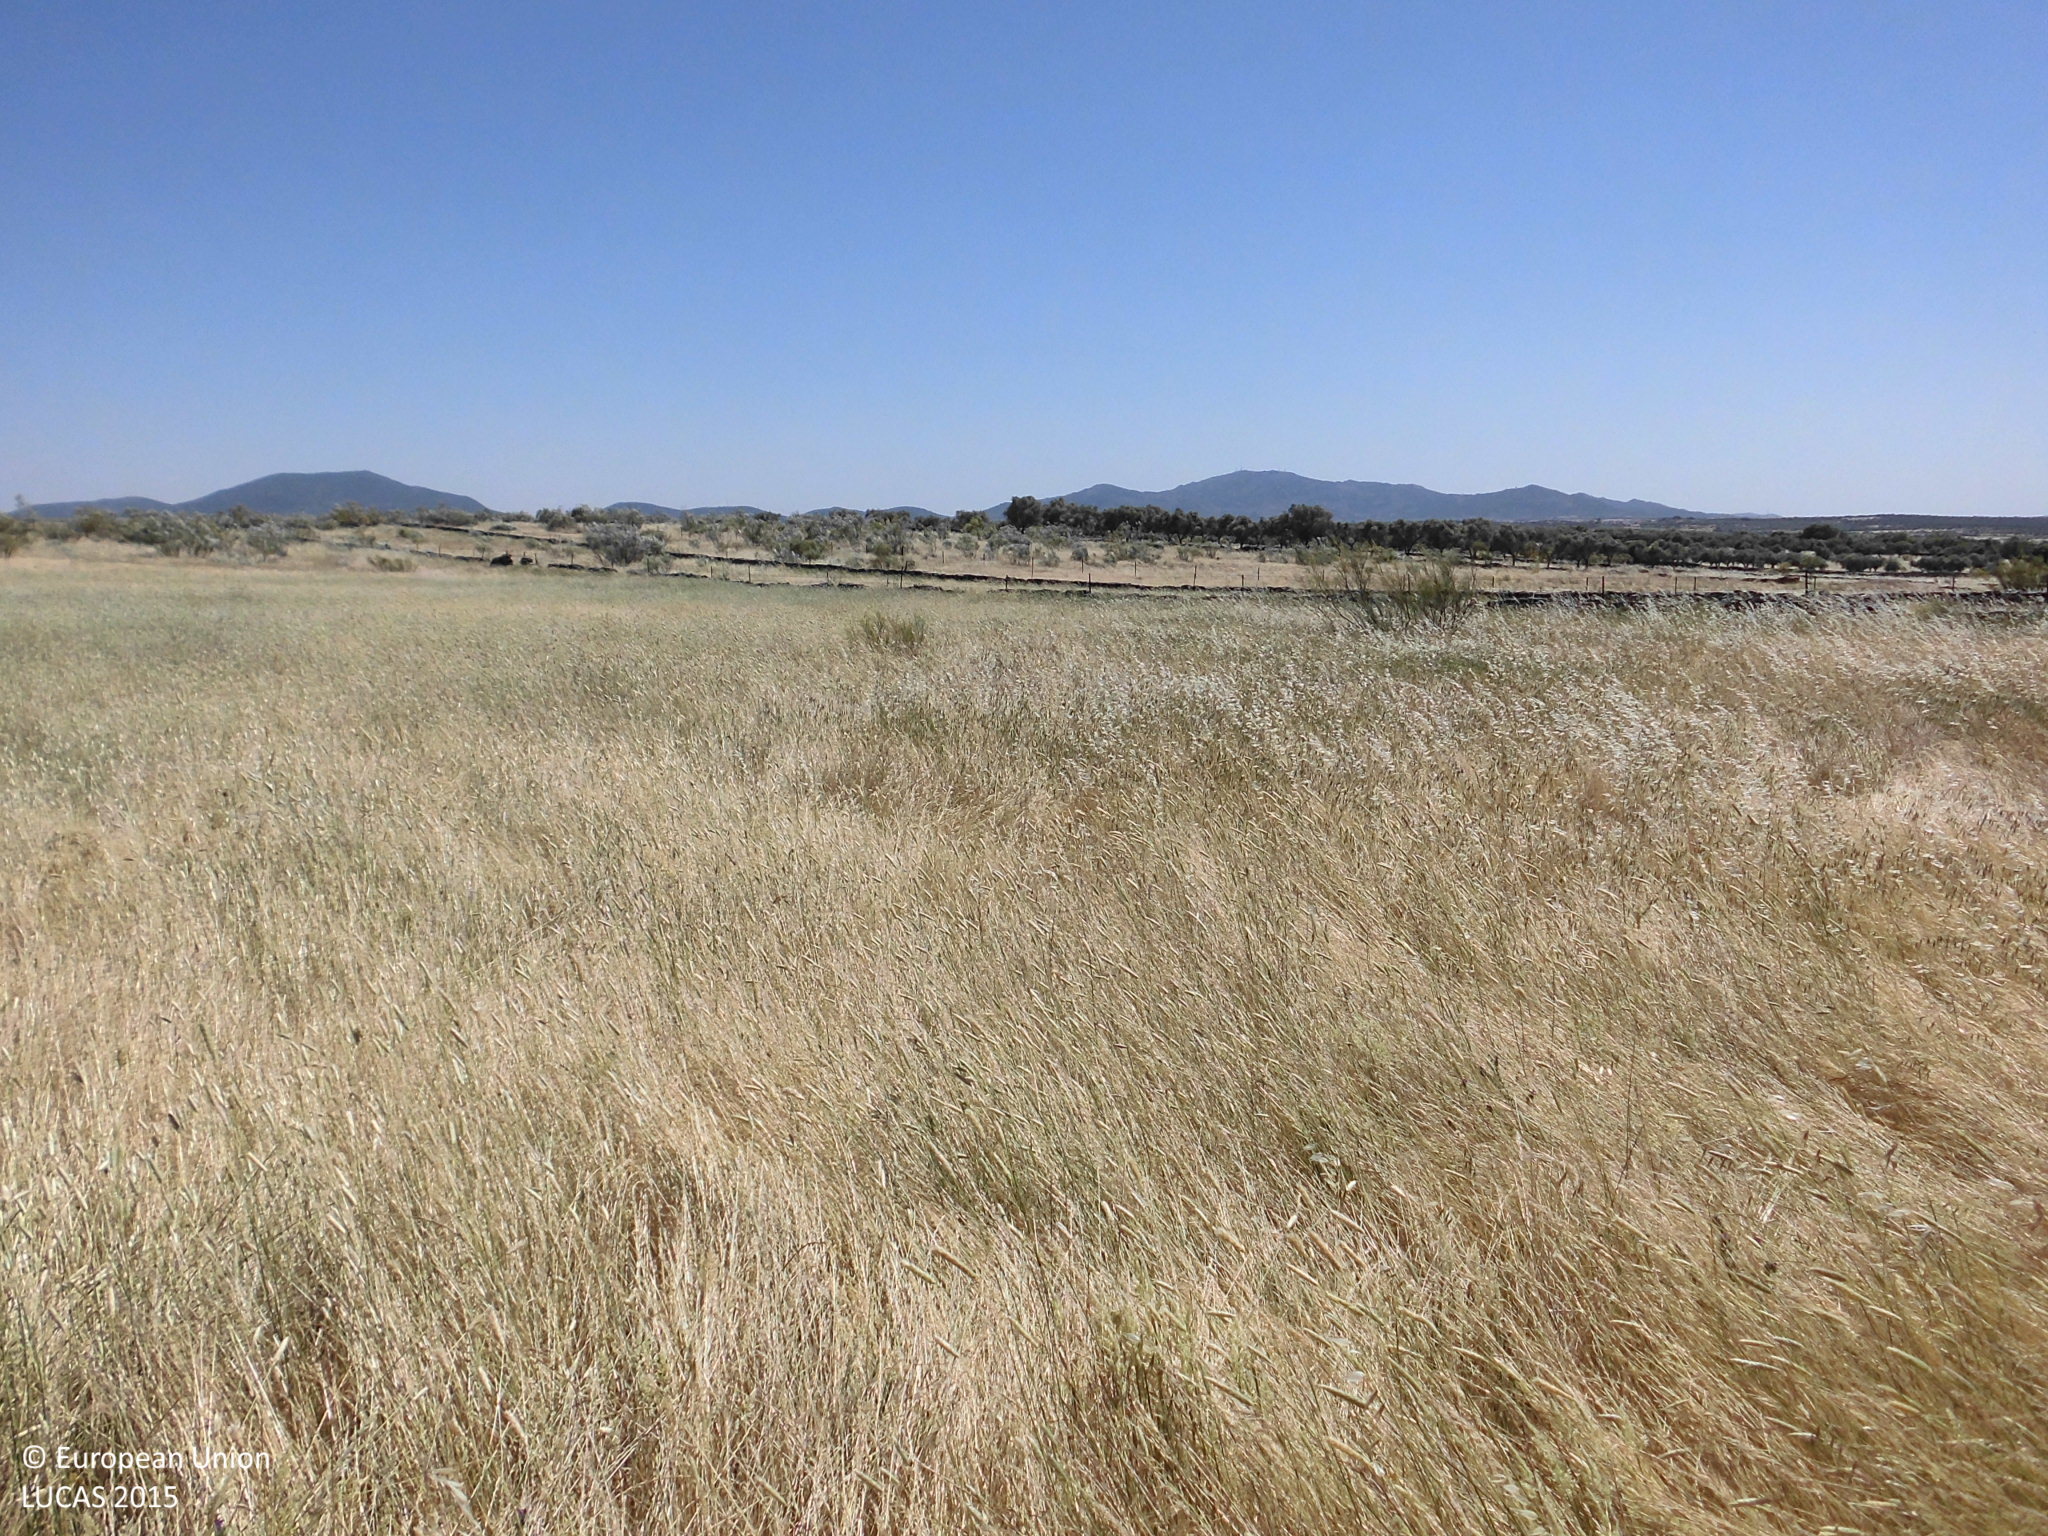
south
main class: Grassland
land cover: Grassland with sparse tree/shrub cover
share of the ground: > 75 %
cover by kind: herbaceous plants 90 %, broadleaved forest trees 5 %, shrubs 5 %
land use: Agriculture (excluding fallow land and kitchen gardens)
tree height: > 5 m
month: May
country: ES
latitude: 39.3396
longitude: -6.0591
